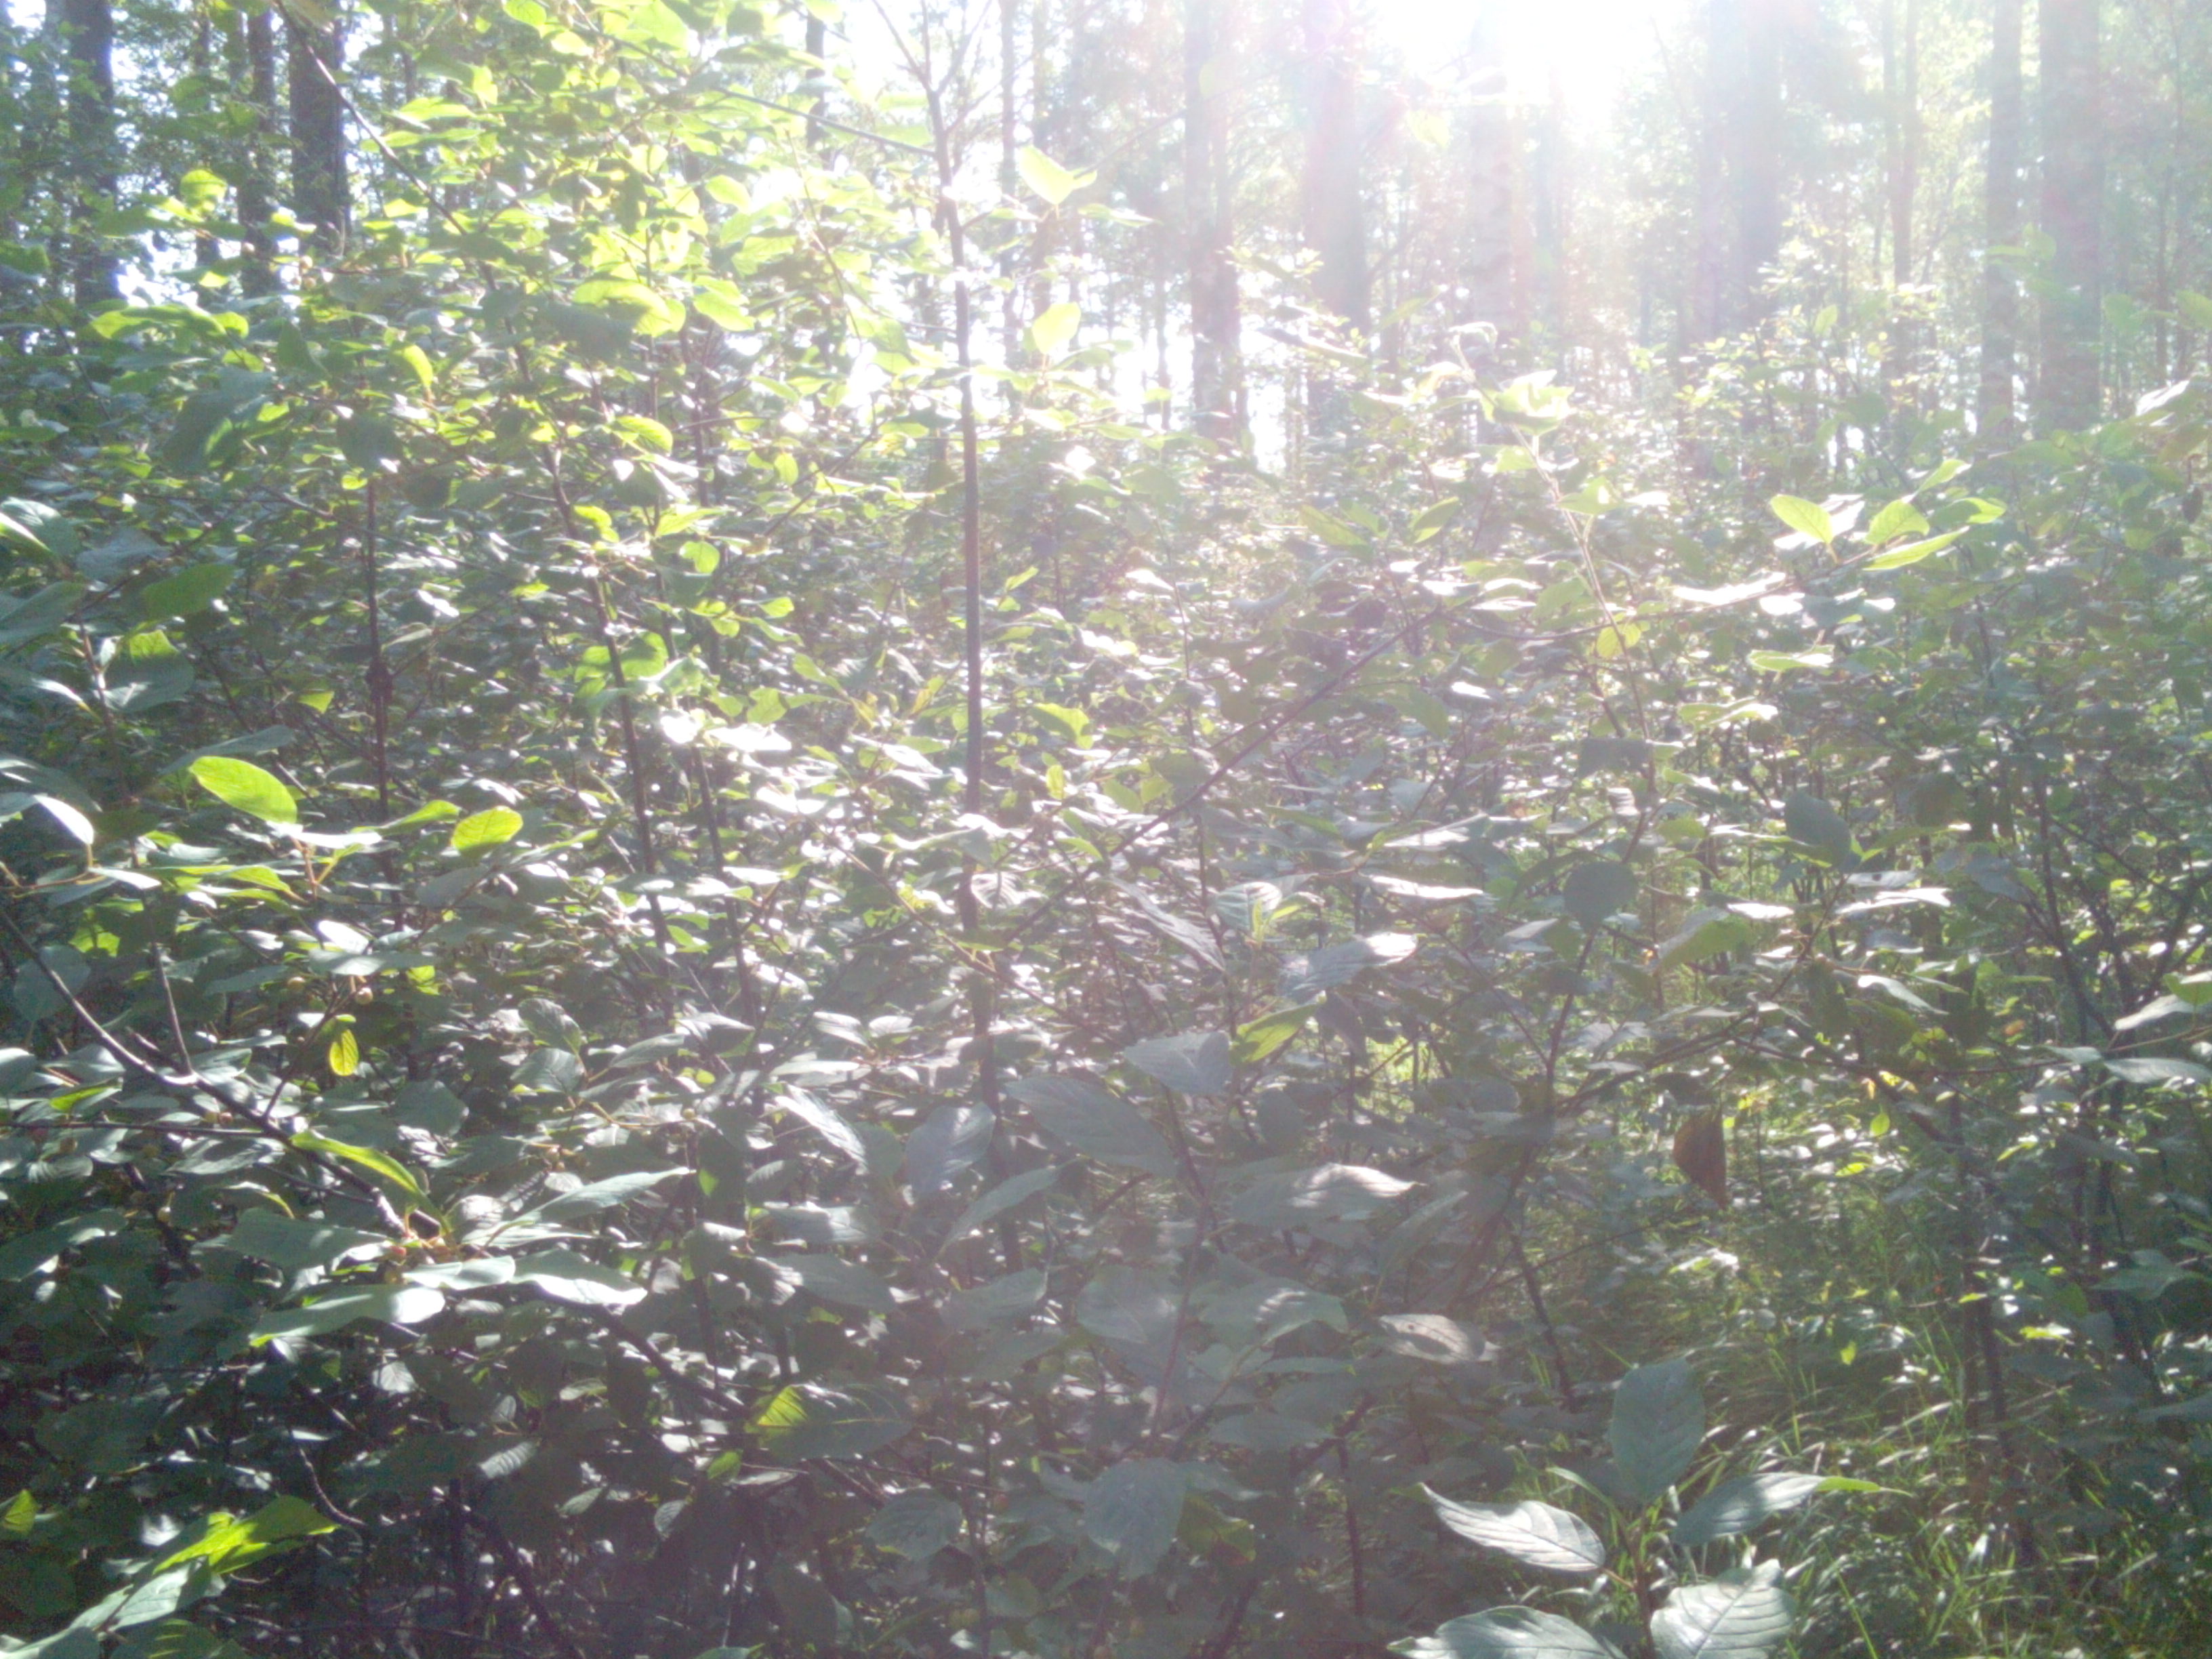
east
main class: Woodland
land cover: Pine dominated mixed woodland
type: hemiboreal forest and nemoral coniferous forest and mixed broadleaved-coniferous forest
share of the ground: > 75 %
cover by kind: coniferous forest trees 50 %, broadleaved forest trees 35 %, herbaceous plants 10 %, shrubs 5 %
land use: Forestry
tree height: > 5 m
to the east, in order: Pine dominated mixed woodland; Groves; Spontaneously vegetated surfaces; Ditches and canals; Grassland with sparse tree/shrub cover; Broadleaved woodland; Other mixed woodland
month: August
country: LV
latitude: 56.7371
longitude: 21.1365
